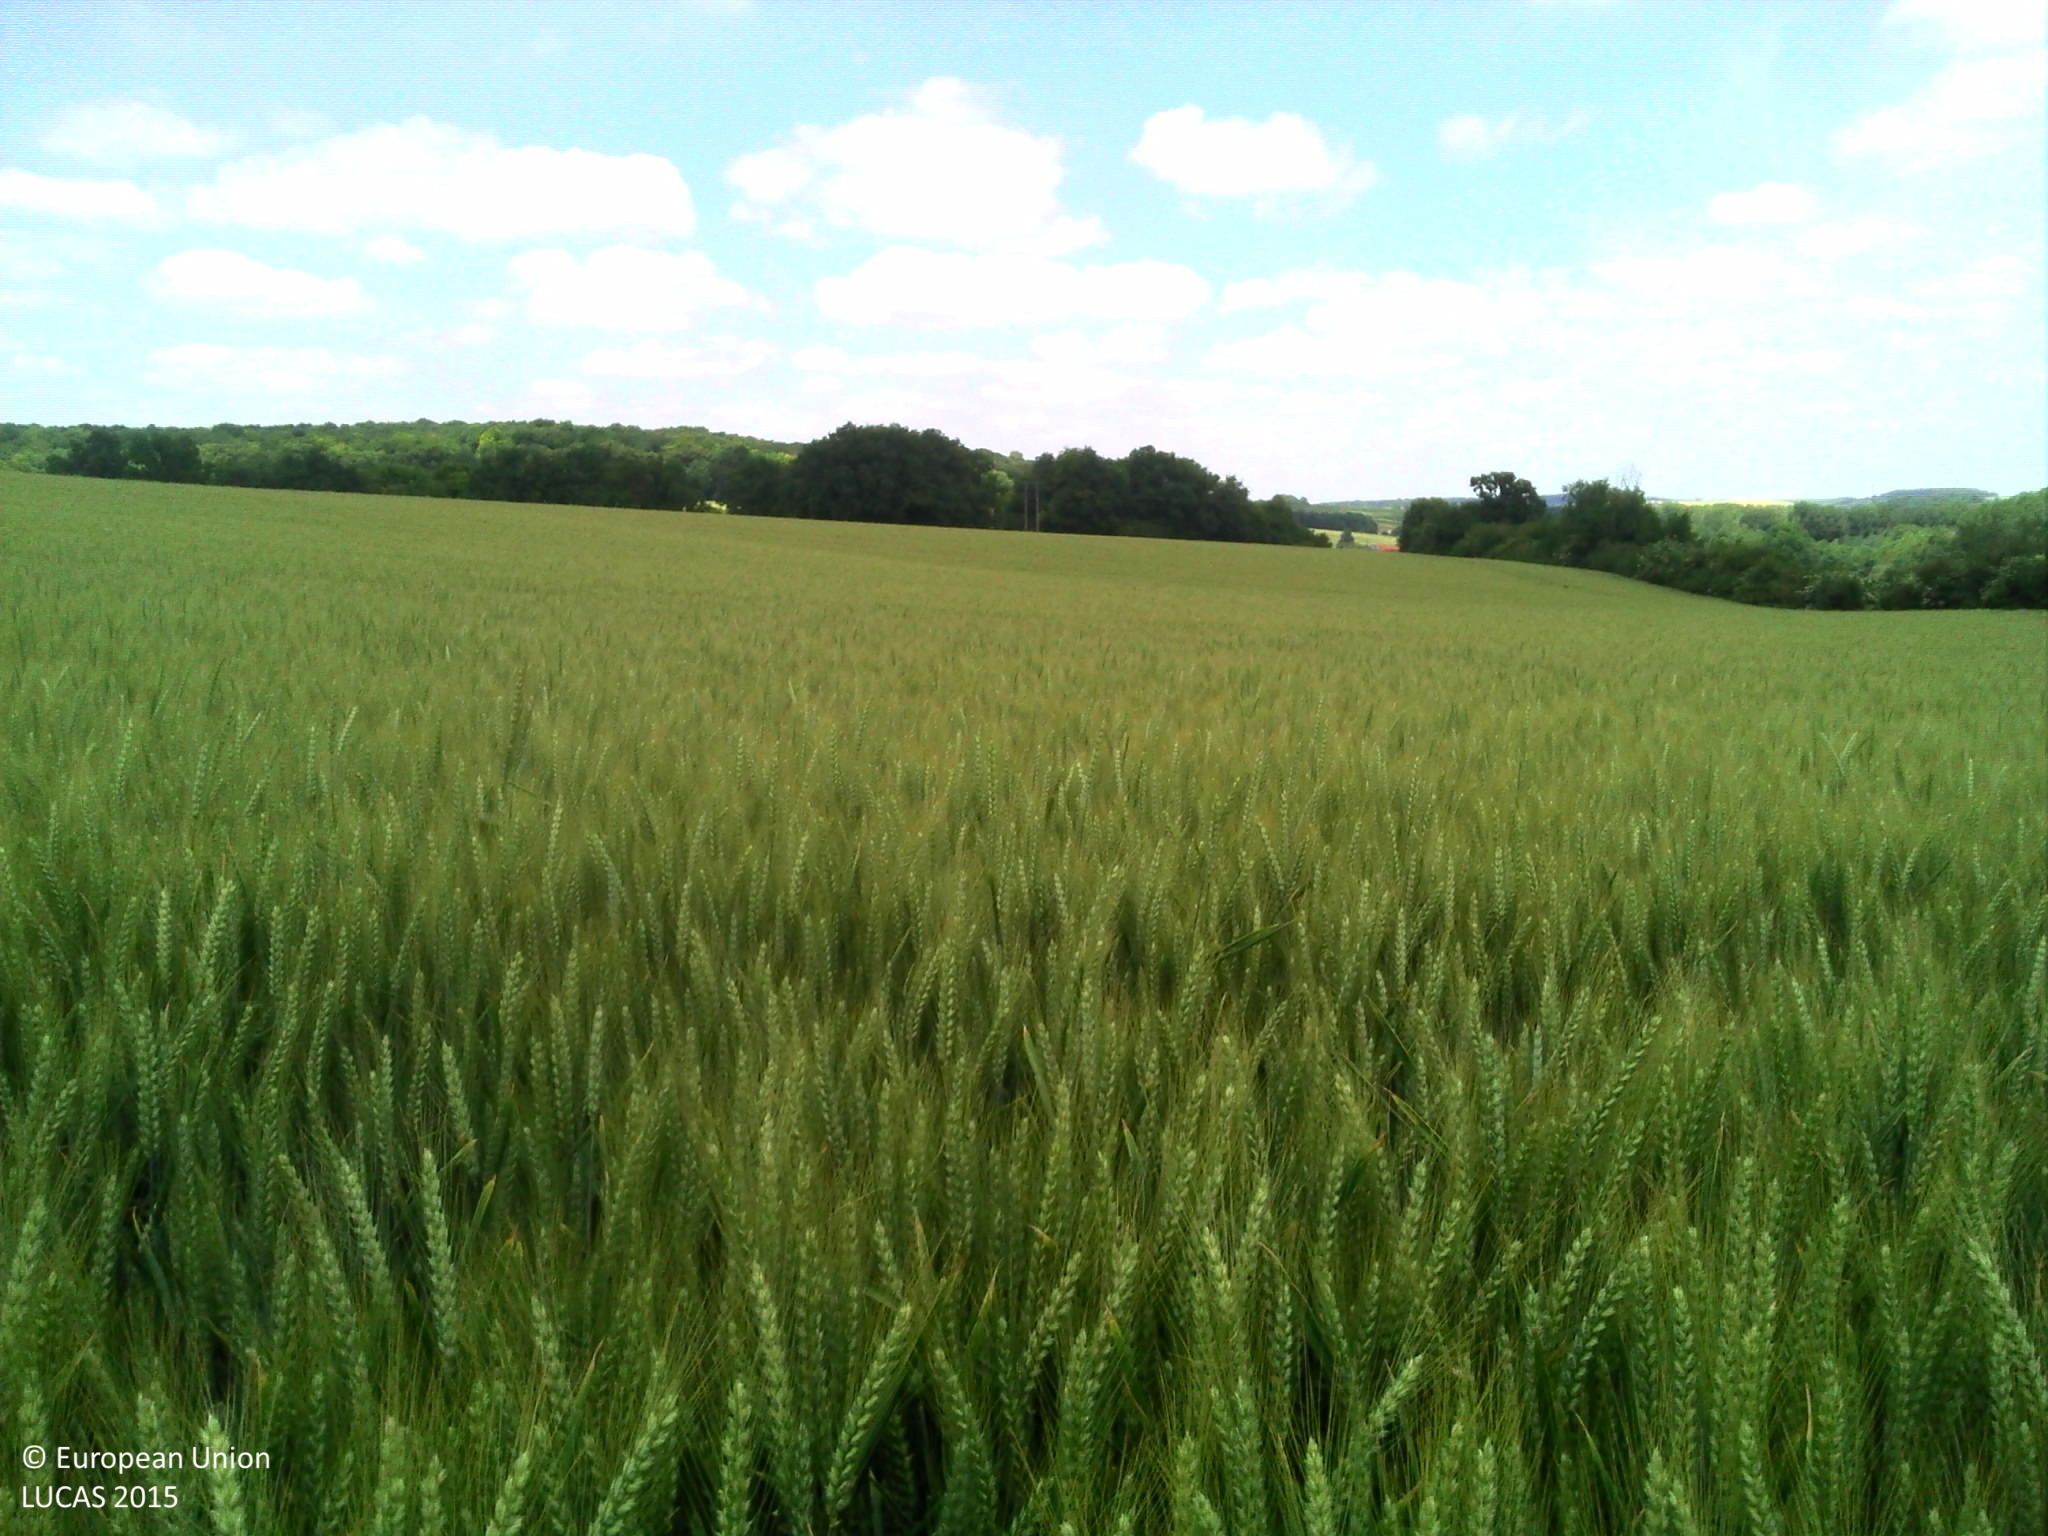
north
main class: Cropland
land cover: Durum wheat
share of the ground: > 75 %
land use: Agriculture (excluding fallow land and kitchen gardens)
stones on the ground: < 10 %
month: June
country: FR
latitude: 49.6675
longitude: 2.5199
